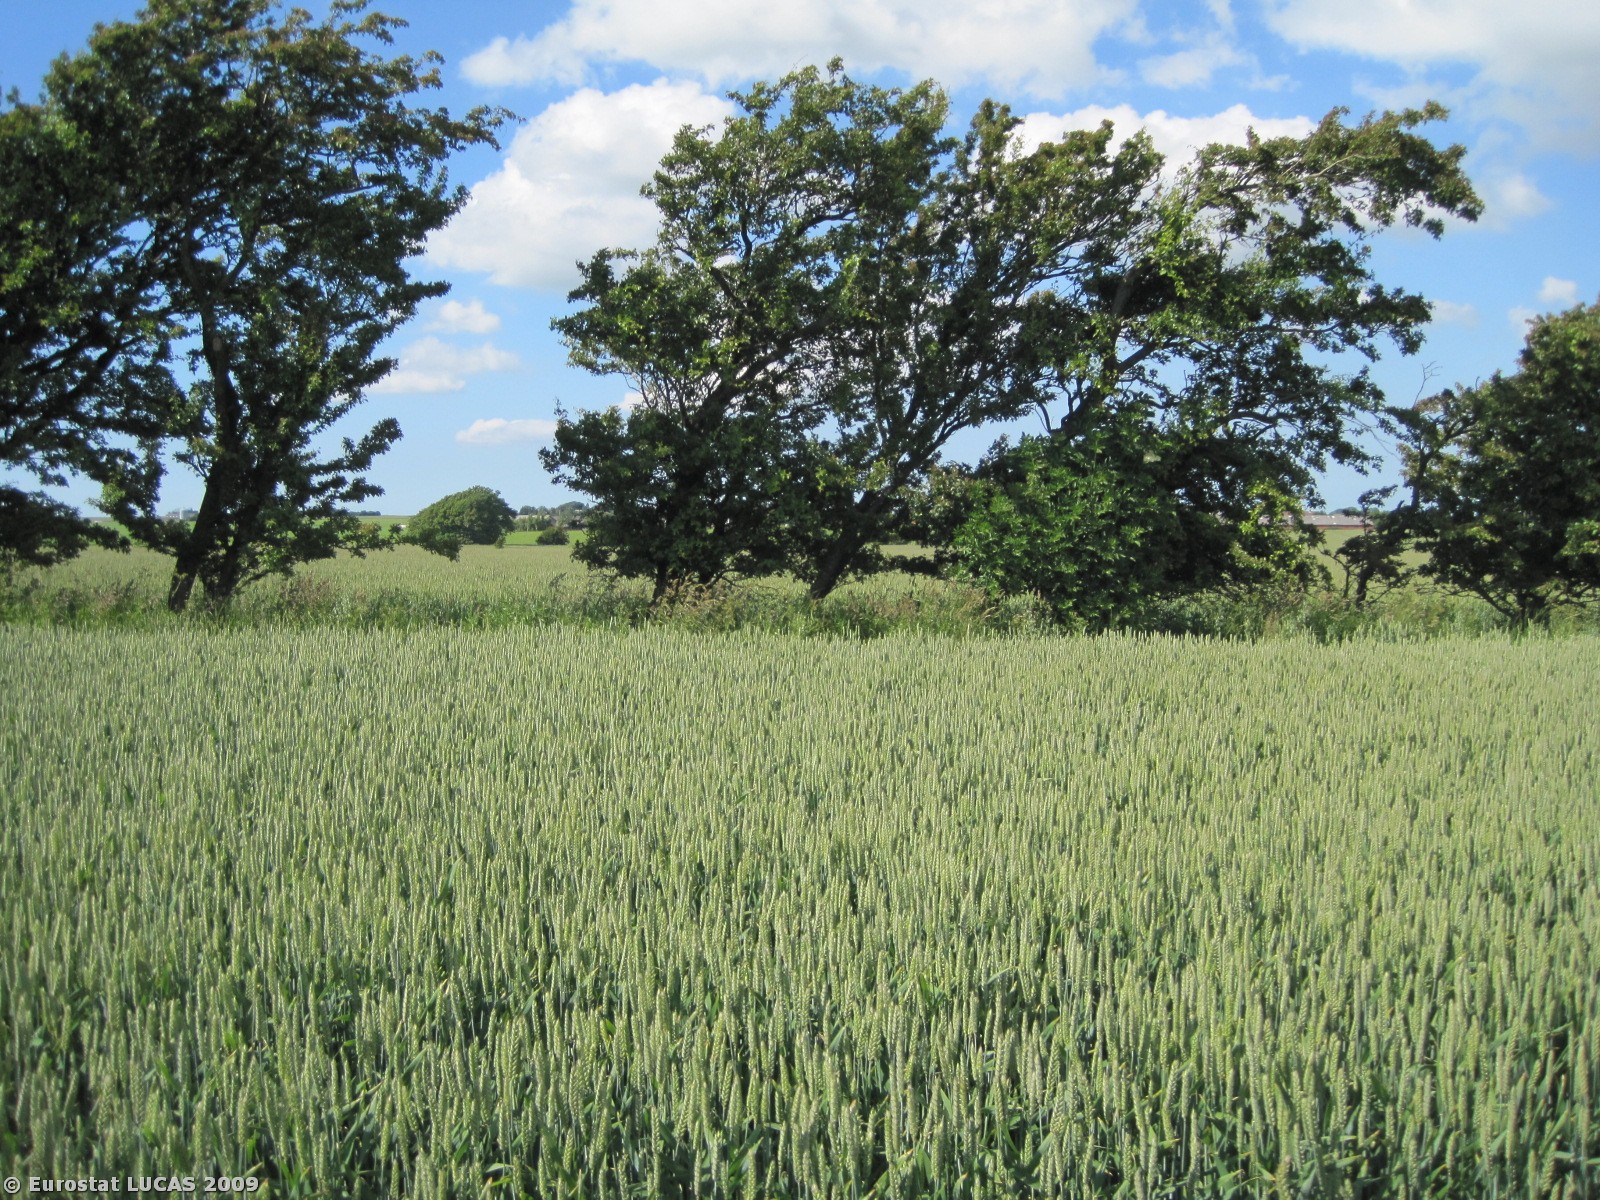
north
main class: Cropland
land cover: Common wheat
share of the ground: > 75 %
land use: Agriculture (excluding fallow land and kitchen gardens)
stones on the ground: < 10 %
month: June
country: DK
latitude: 56.5971
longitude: 8.9753
